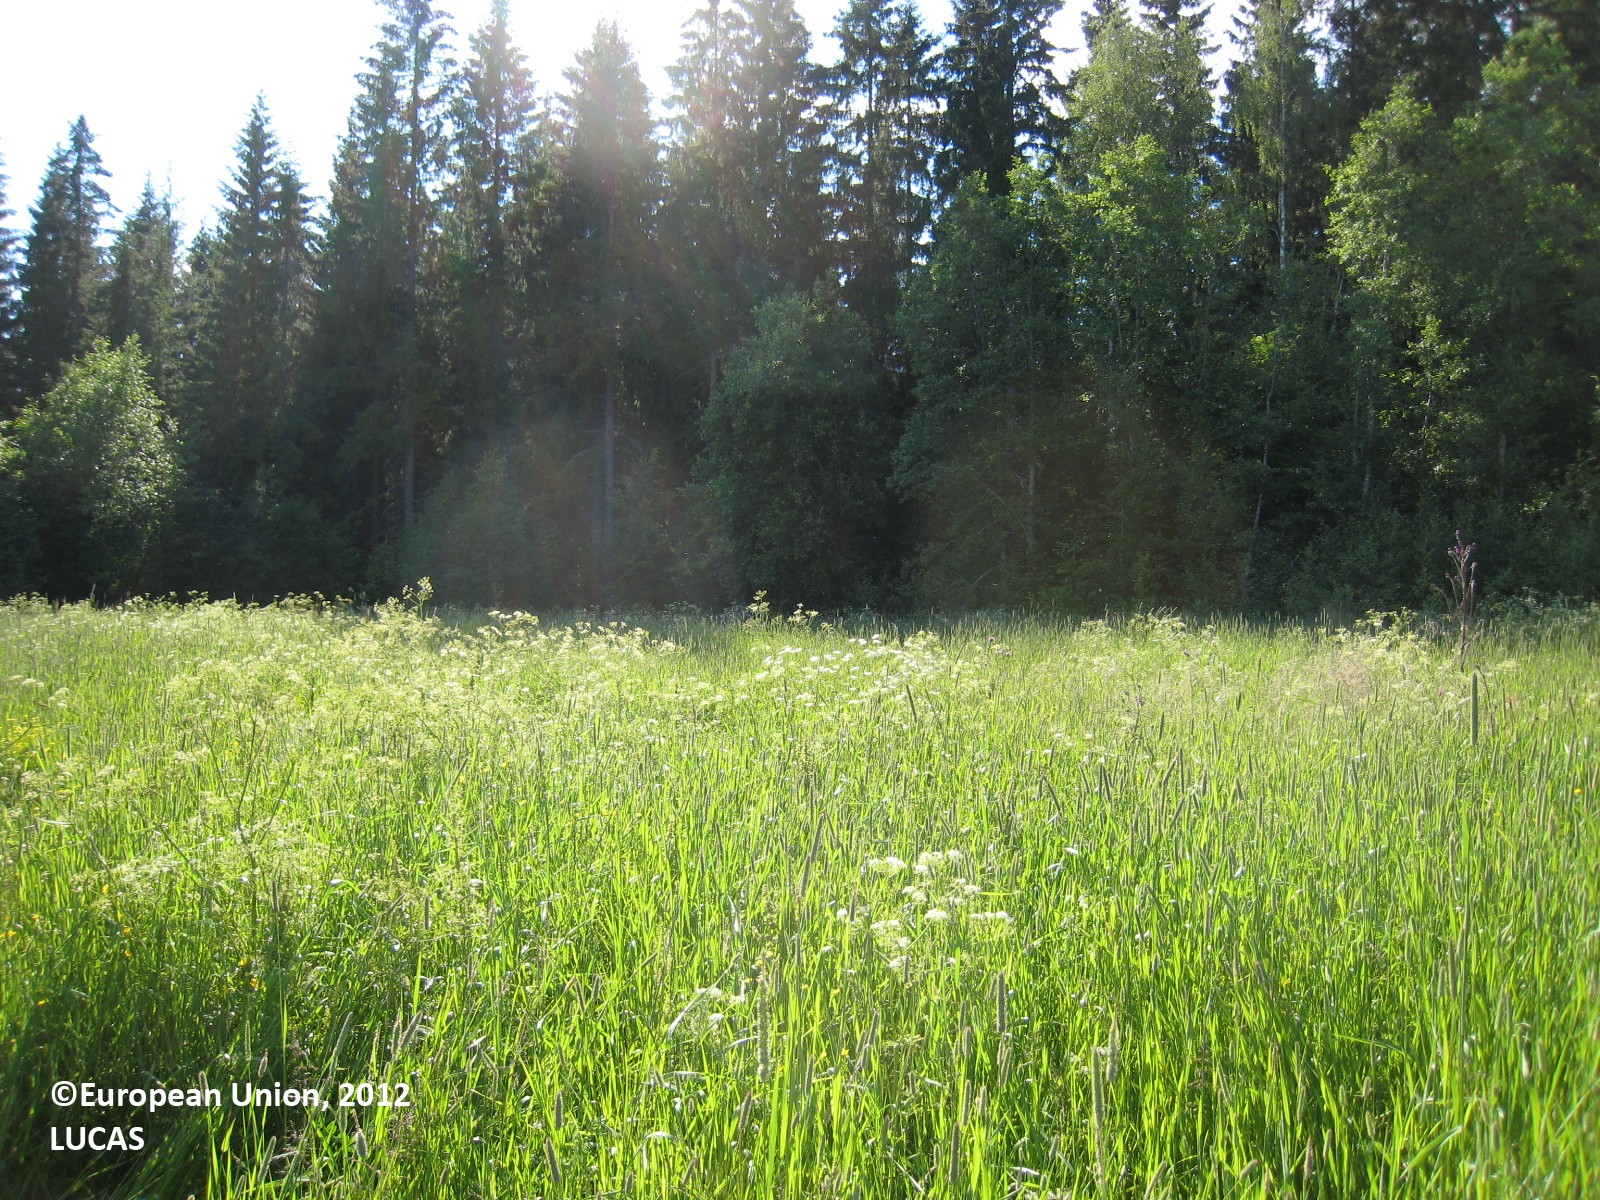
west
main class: Cropland
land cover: Temporary grasslands
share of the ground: > 75 %
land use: Agriculture (excluding fallow land and kitchen gardens)
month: July
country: FI
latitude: 62.6385
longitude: 26.1383
